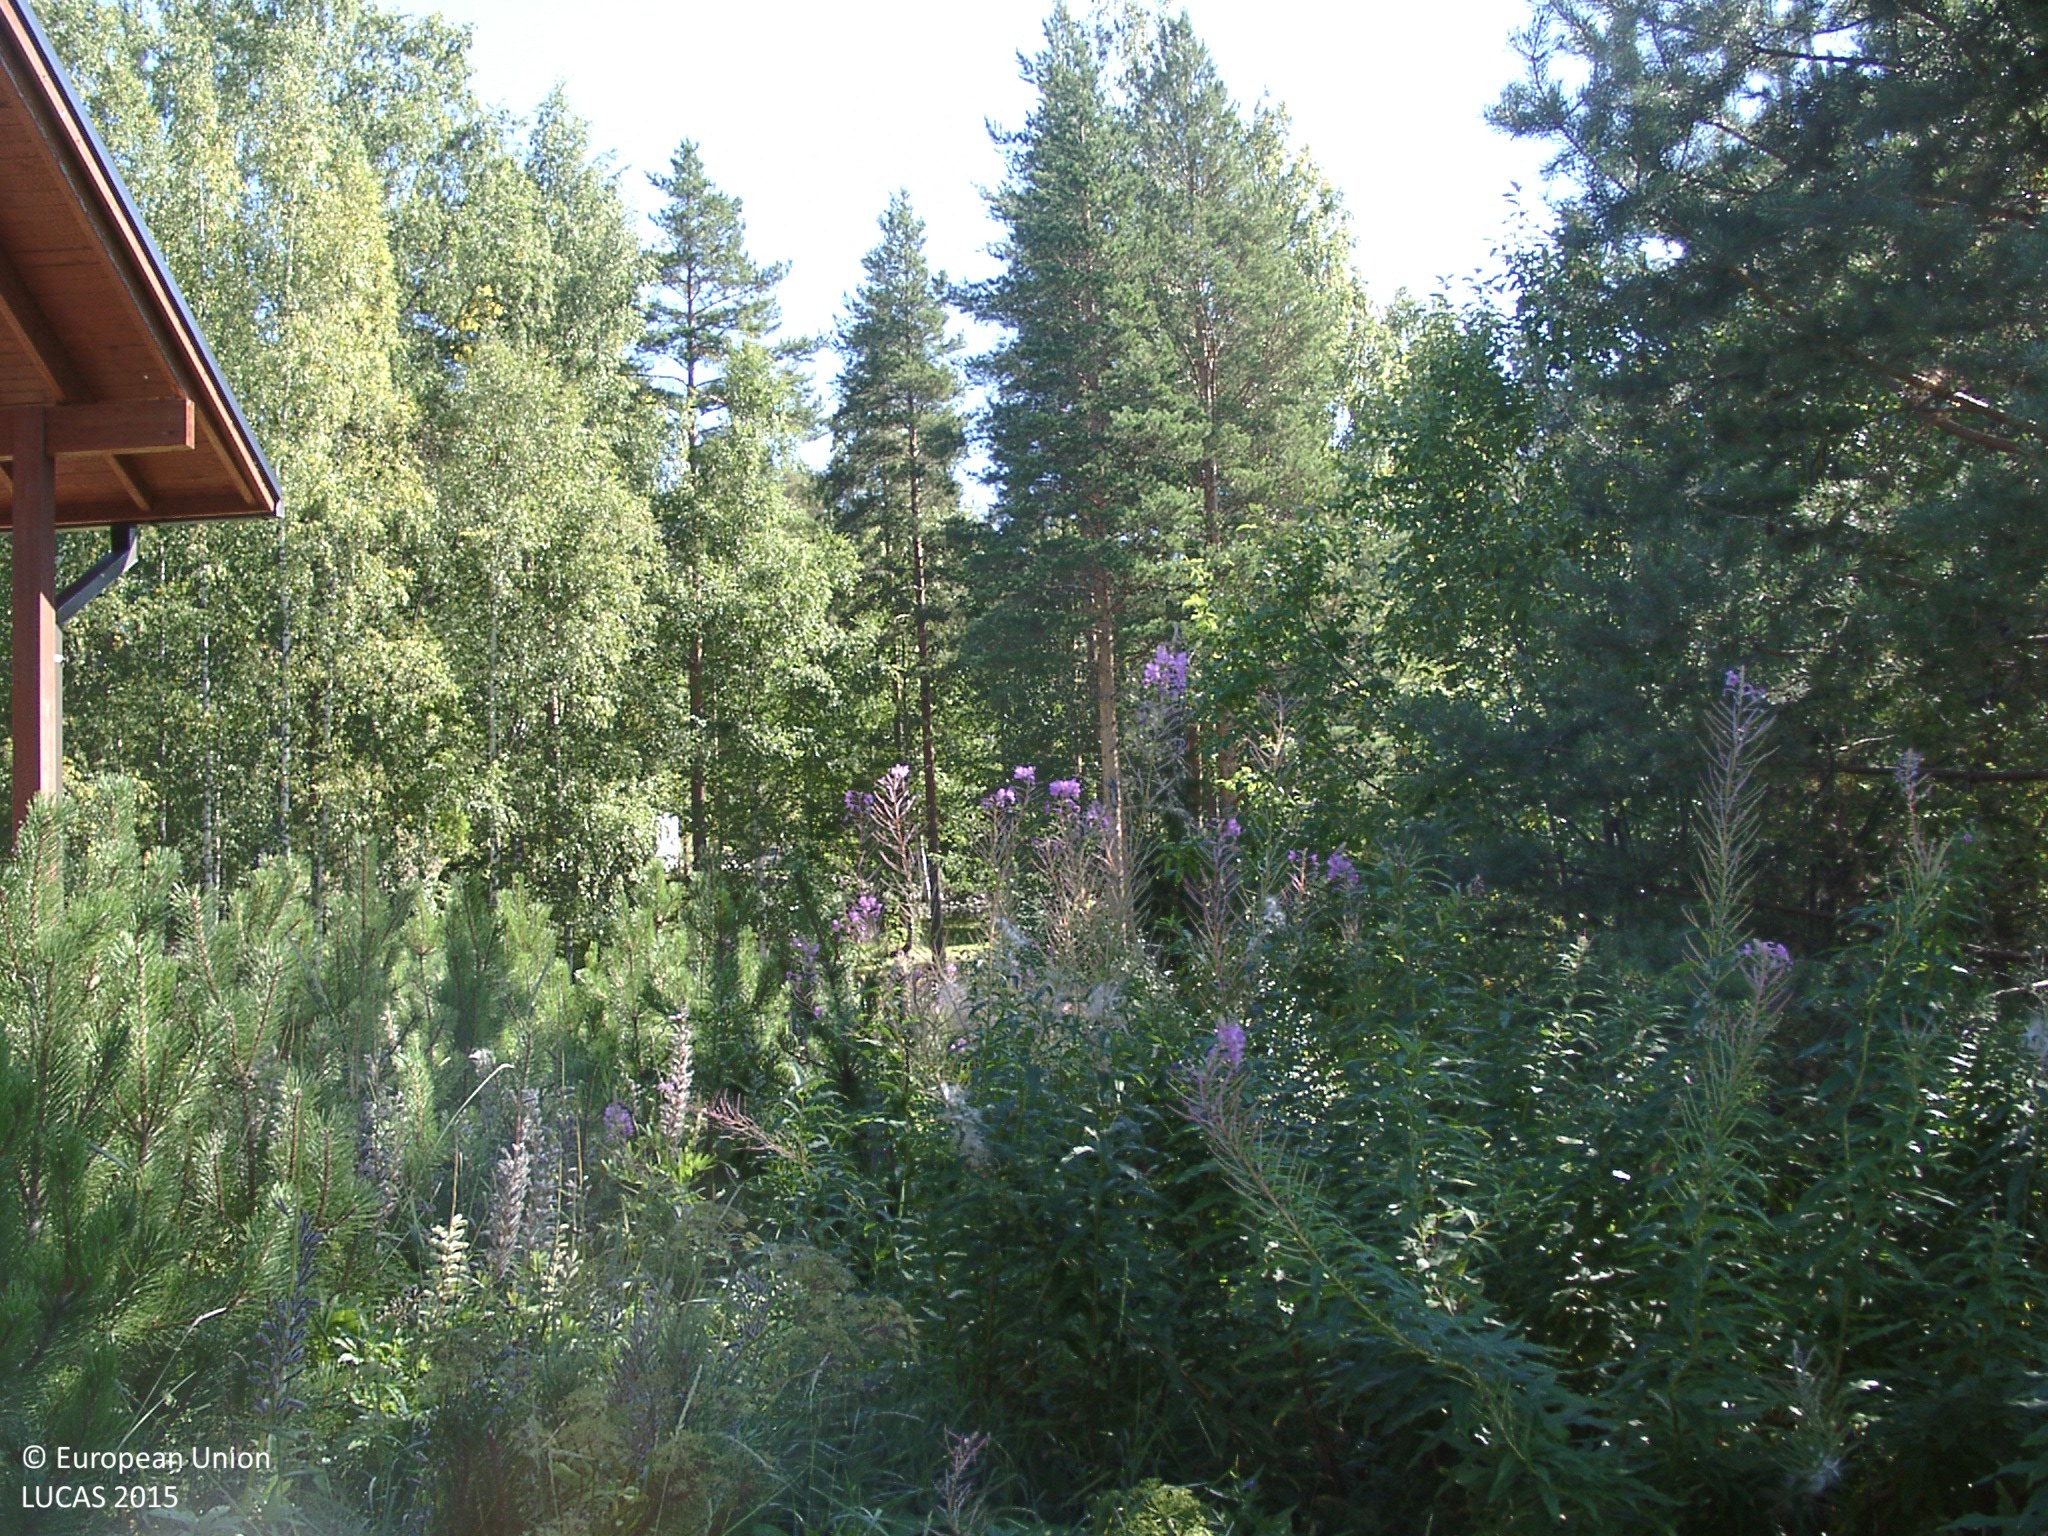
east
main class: Grassland
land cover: Spontaneously vegetated surfaces
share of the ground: > 75 %
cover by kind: herbaceous plants 100 %
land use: Residential
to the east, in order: Abandoned hedges; Spontaneously vegetated surfaces; Tracks; Broadleaved woodland; Fences; Grass margins; Tracks; Grass margins; Pine dominated mixed woodland; Pine dominated coniferous woodland; Artificial constructions in urban areas; Pine dominated mixed woodland; Grassland without tree/shrub cover; Broadleaved woodland
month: August
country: FI
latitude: 61.8954
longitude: 25.3170
